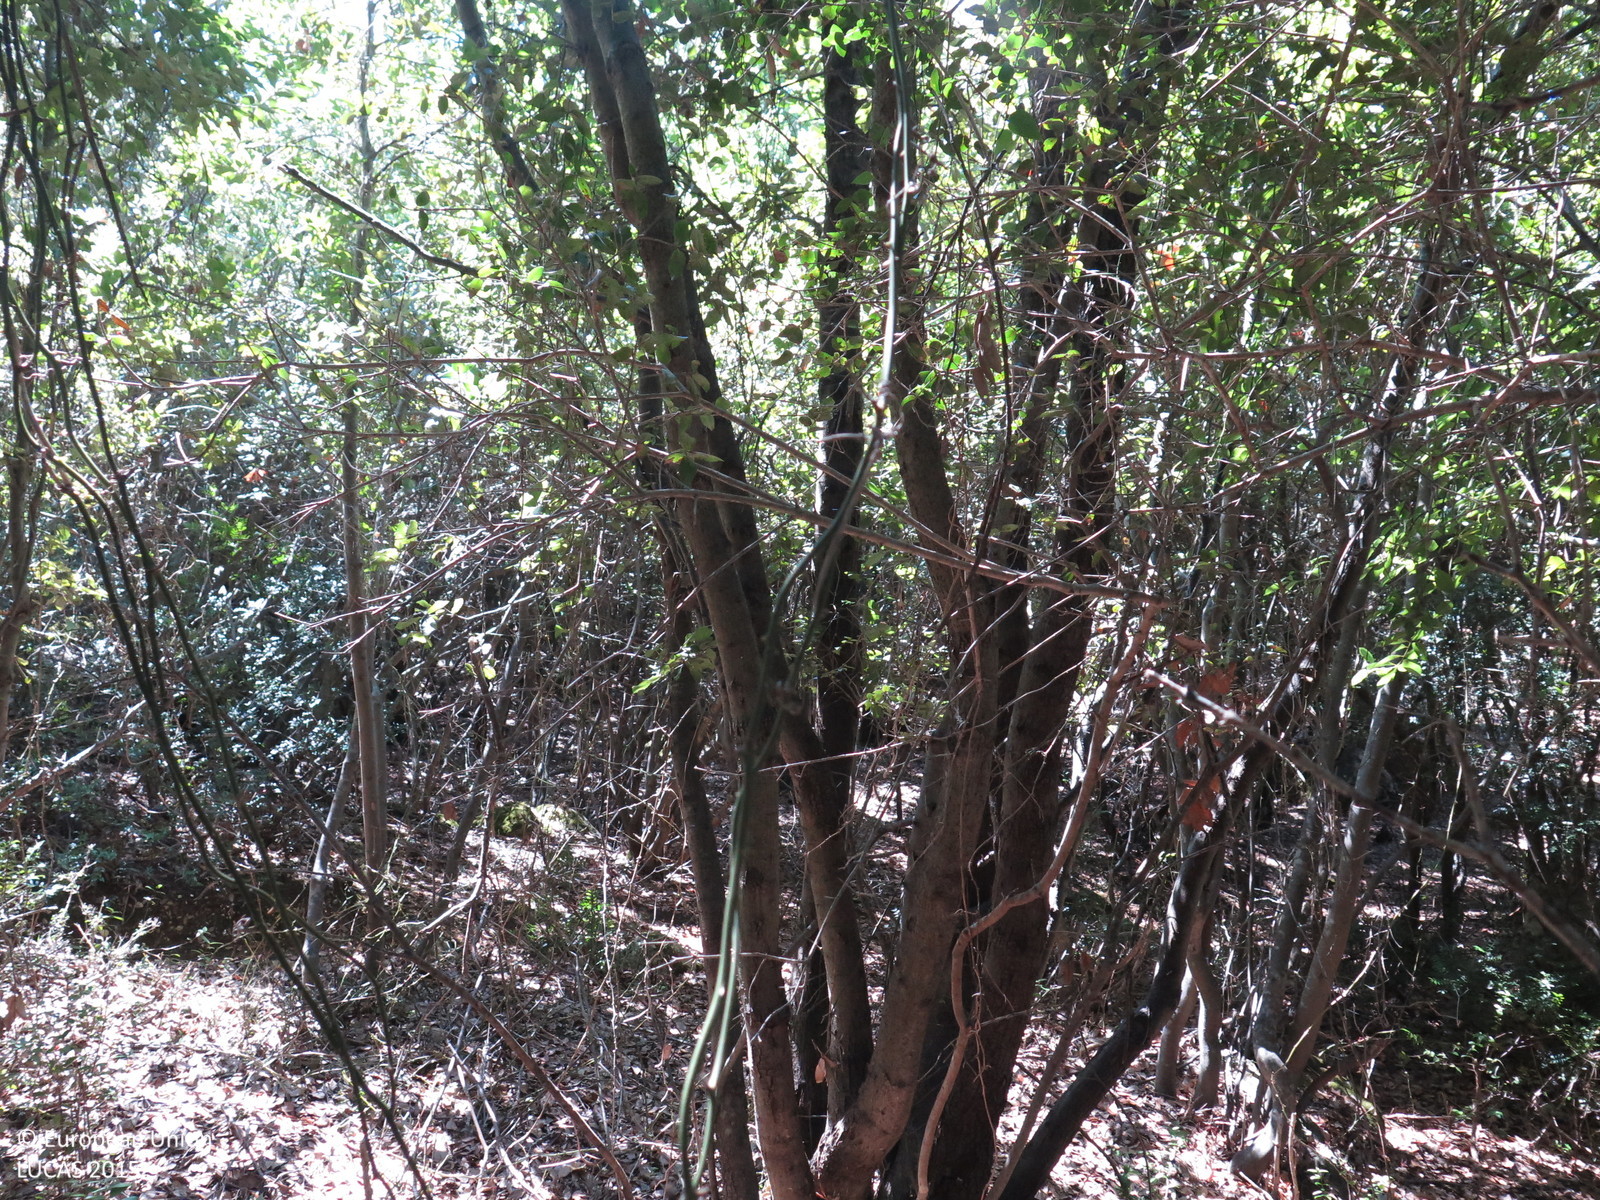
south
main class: Woodland
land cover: Broadleaved woodland
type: thermophilous deciduous forest
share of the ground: > 75 %
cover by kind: broadleaved forest trees 90 %, shrubs 5 %, herbaceous plants 5 %
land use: Semi-natural and natural areas not in use
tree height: < 5 m
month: September
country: HR
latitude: 44.6325
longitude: 14.4935
